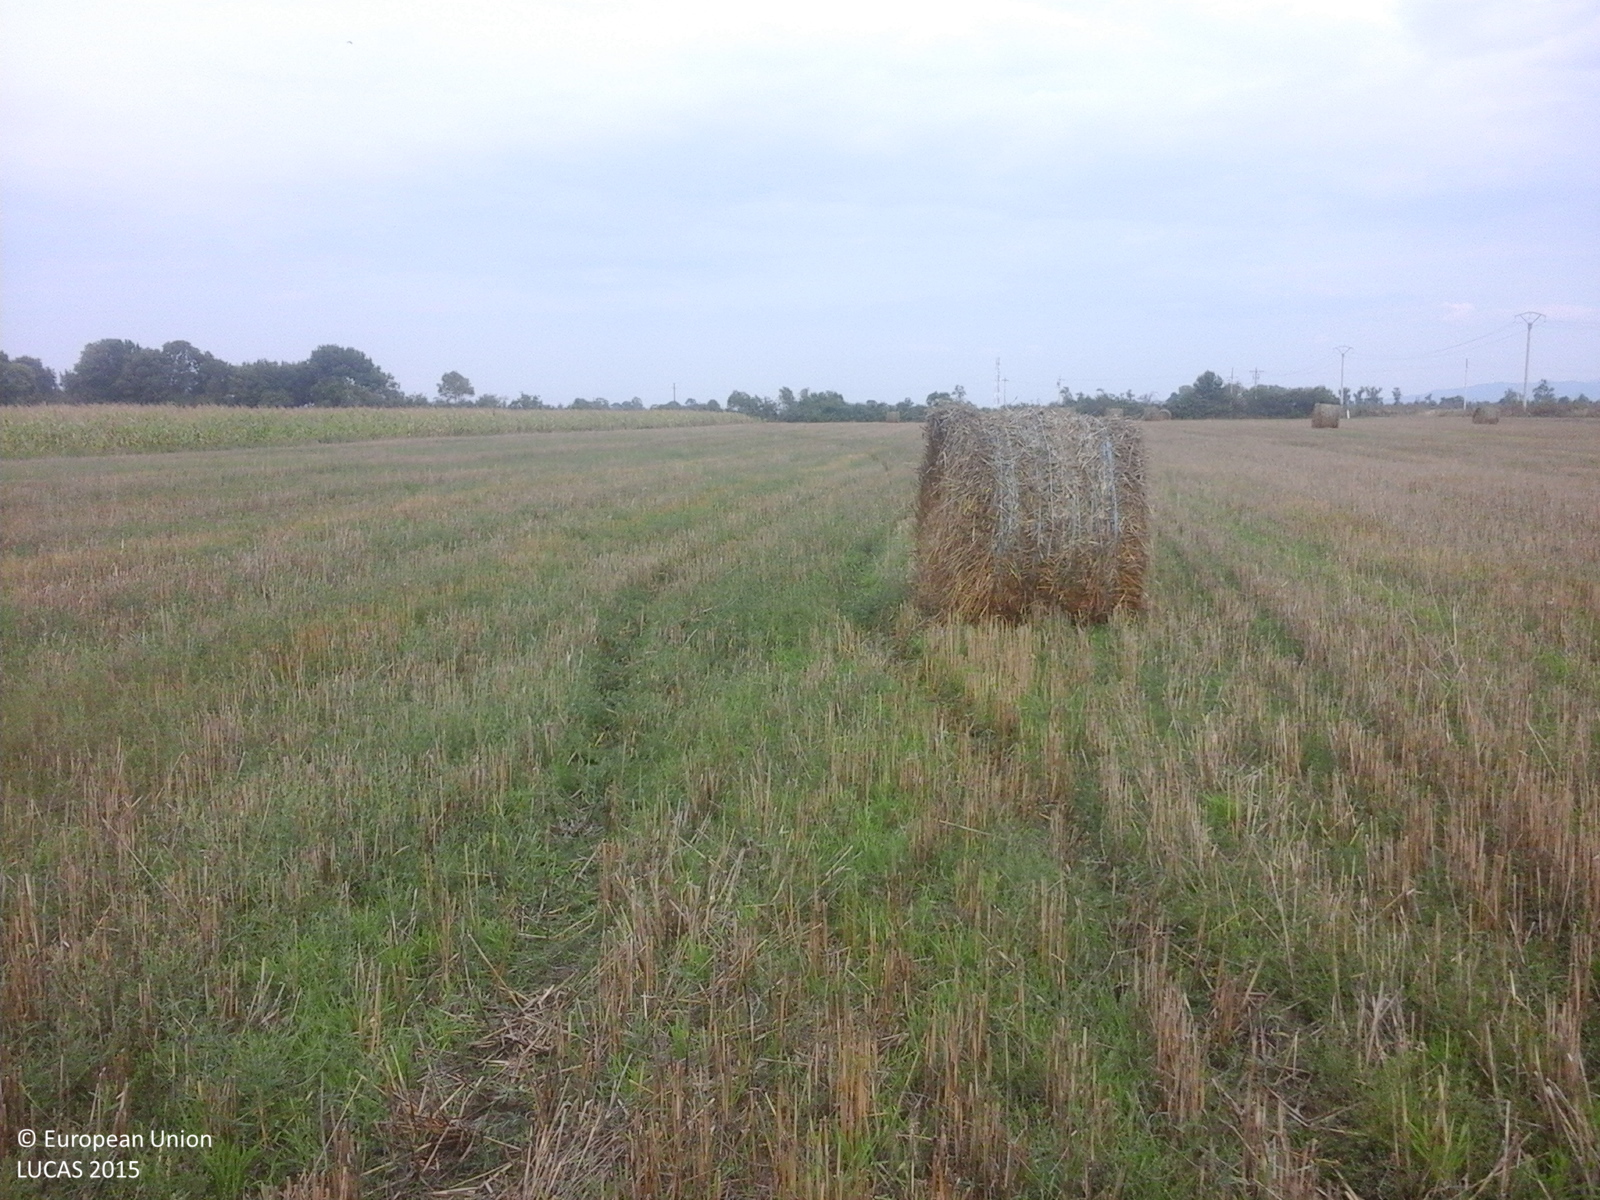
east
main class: Cropland
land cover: Common wheat
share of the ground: 50 - 75 %
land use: Agriculture (excluding fallow land and kitchen gardens)
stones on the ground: < 10 %
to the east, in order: Common wheat; Maize; Shrubland without tree cover; Grass margins; Tracks; Grass margins; Fences; Grassland without tree/shrub cover
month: August
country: RO
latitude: 46.3569
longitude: 21.4076
